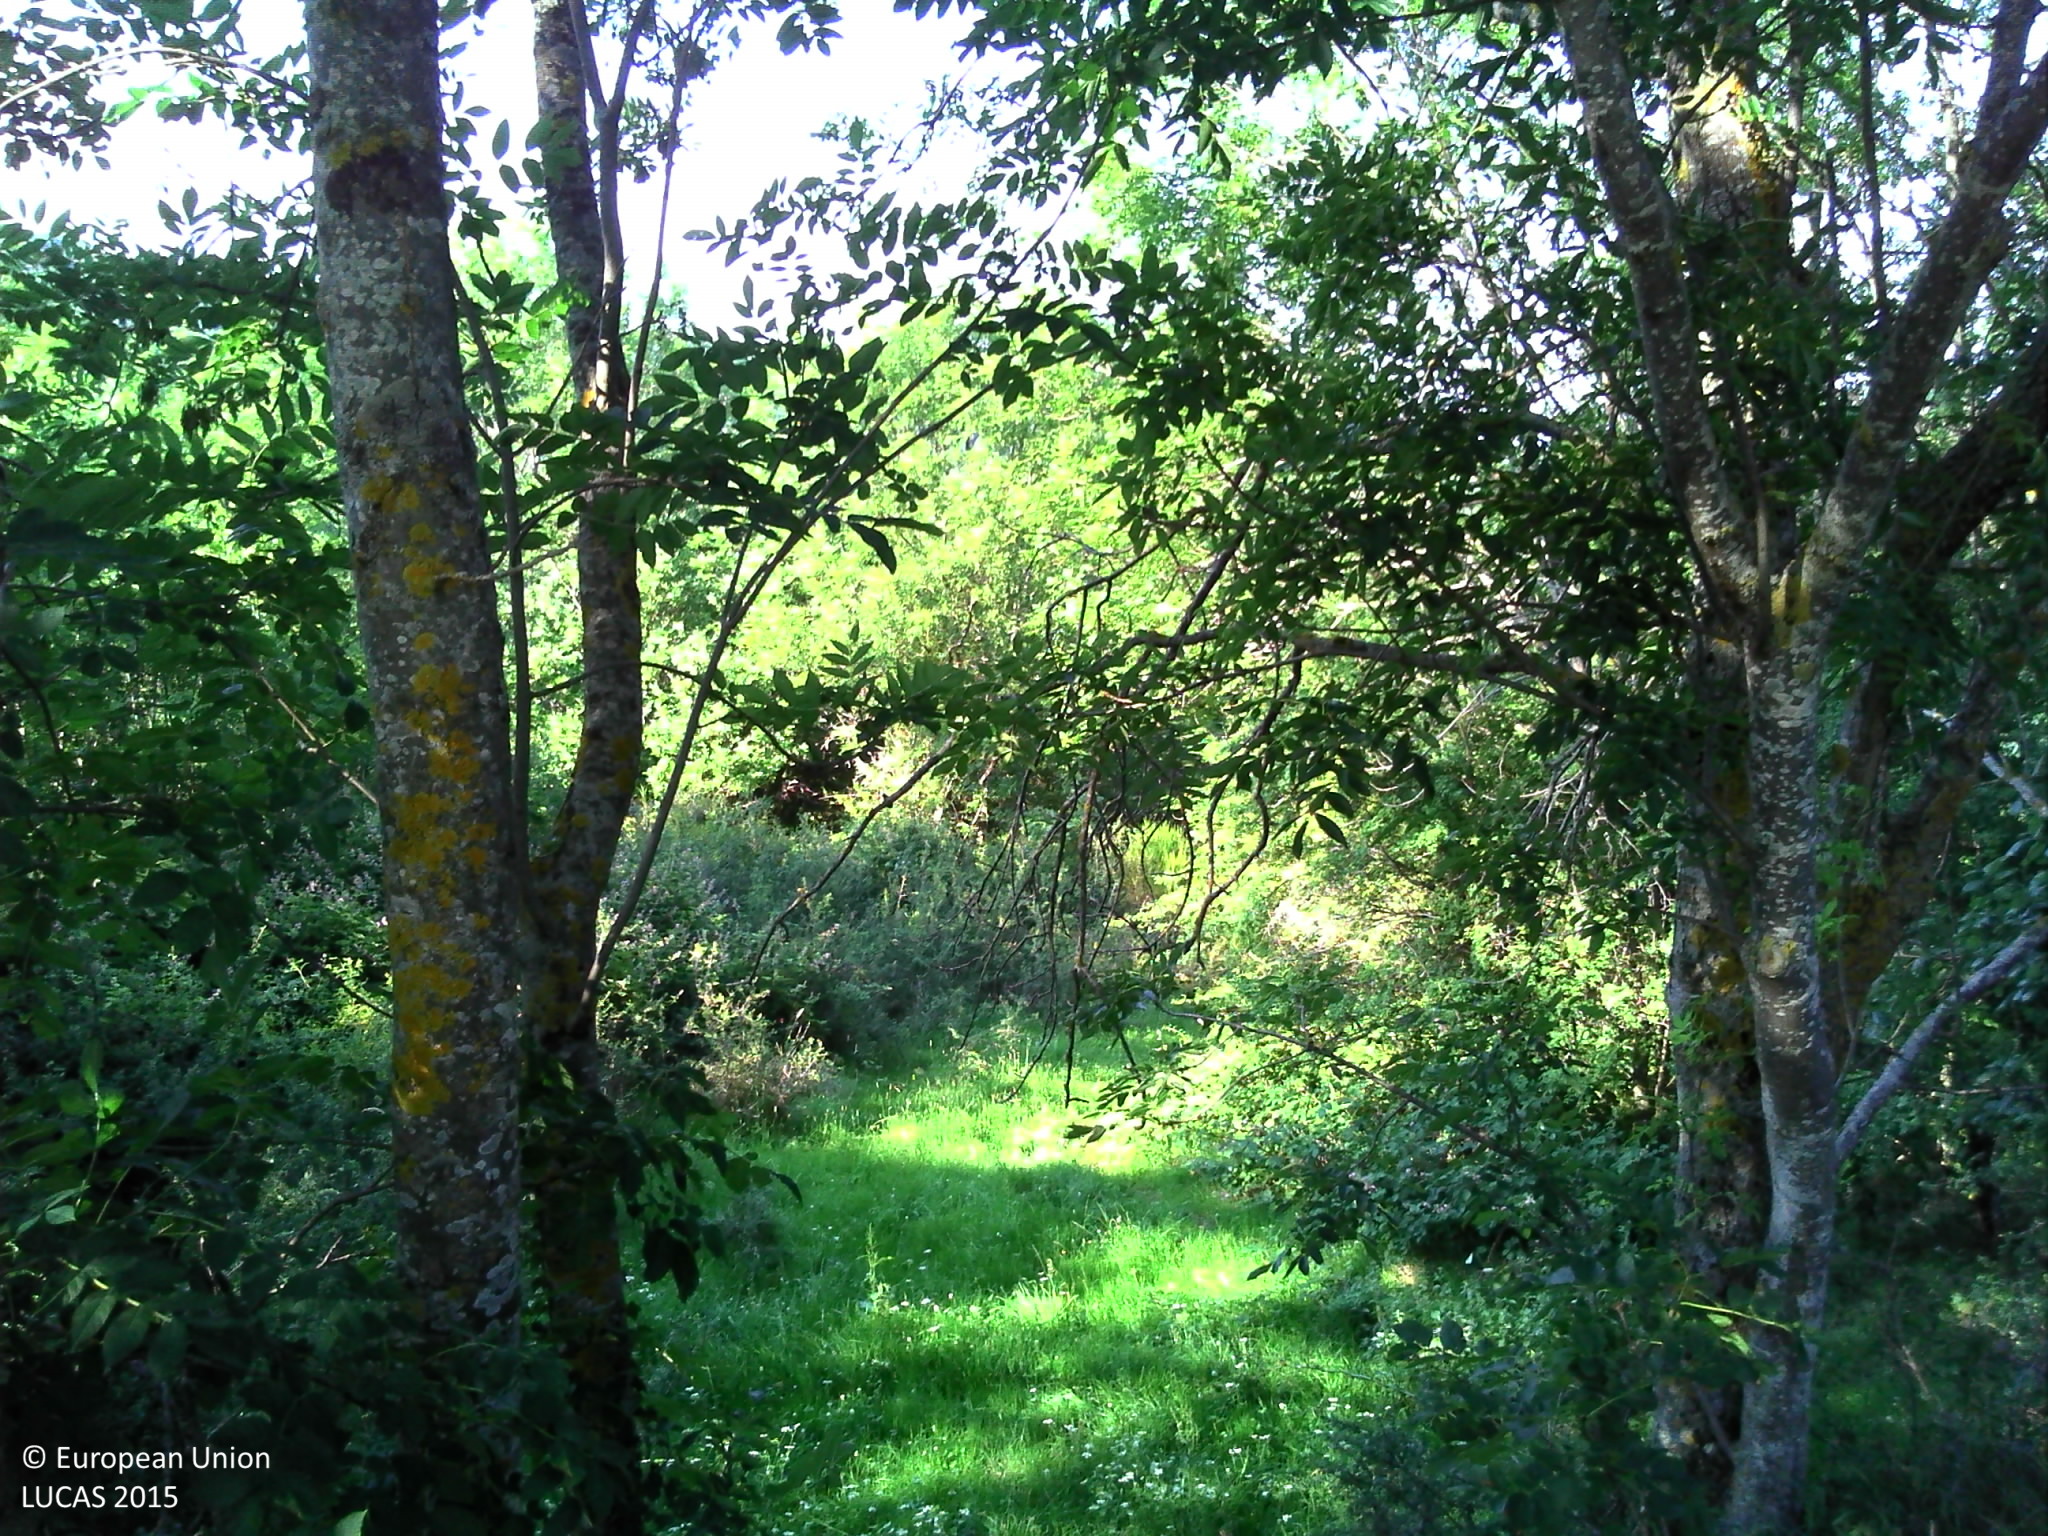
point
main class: Woodland
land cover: Broadleaved woodland
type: mesophytic deciduous forest
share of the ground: > 75 %
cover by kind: broadleaved forest trees 90 %, shrubs 5 %, herbaceous plants 5 %
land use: Forestry
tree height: > 5 m
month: July
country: FR
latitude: 45.4778
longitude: 3.1055
